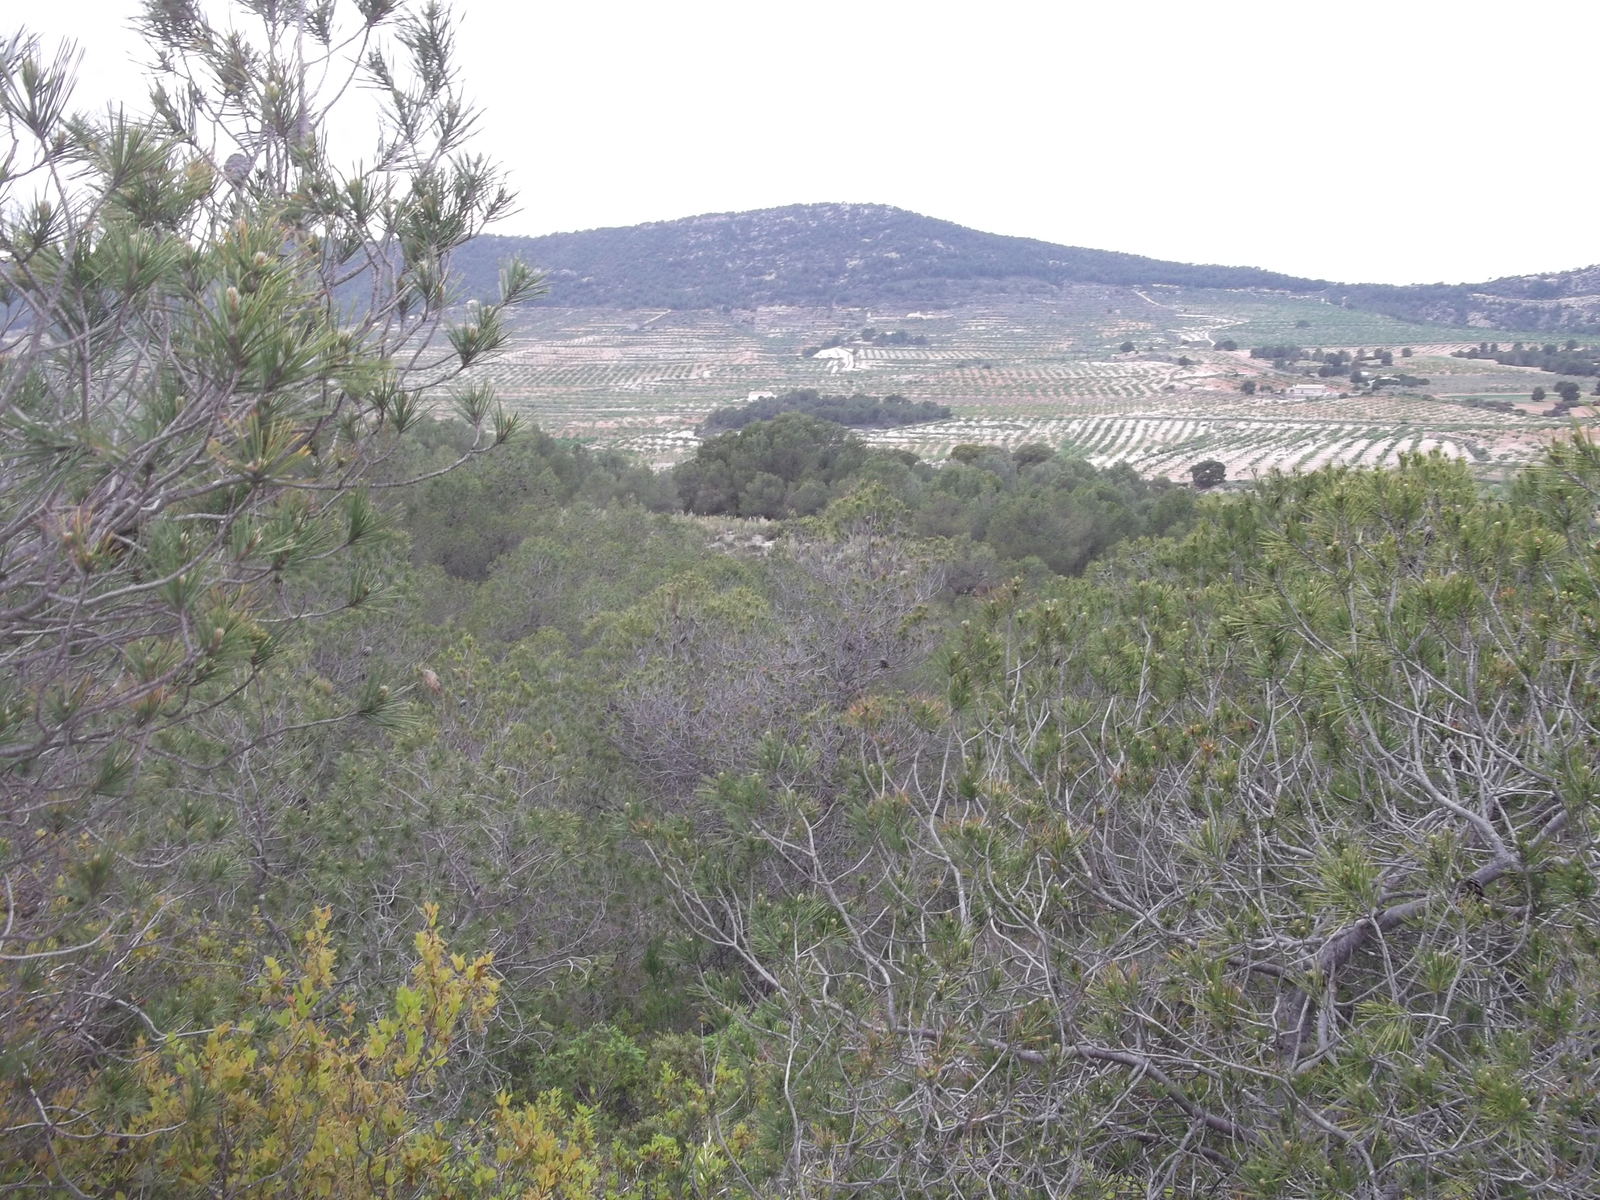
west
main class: Woodland
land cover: Pine dominated coniferous woodland
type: coniferous forest of the mediterranean region
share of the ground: 25 - 50 %
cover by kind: shrubs 65 %, coniferous forest trees 35 %
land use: Semi-natural and natural areas not in use
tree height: > 5 m
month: April
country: ES
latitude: 38.0776
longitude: -1.6040
